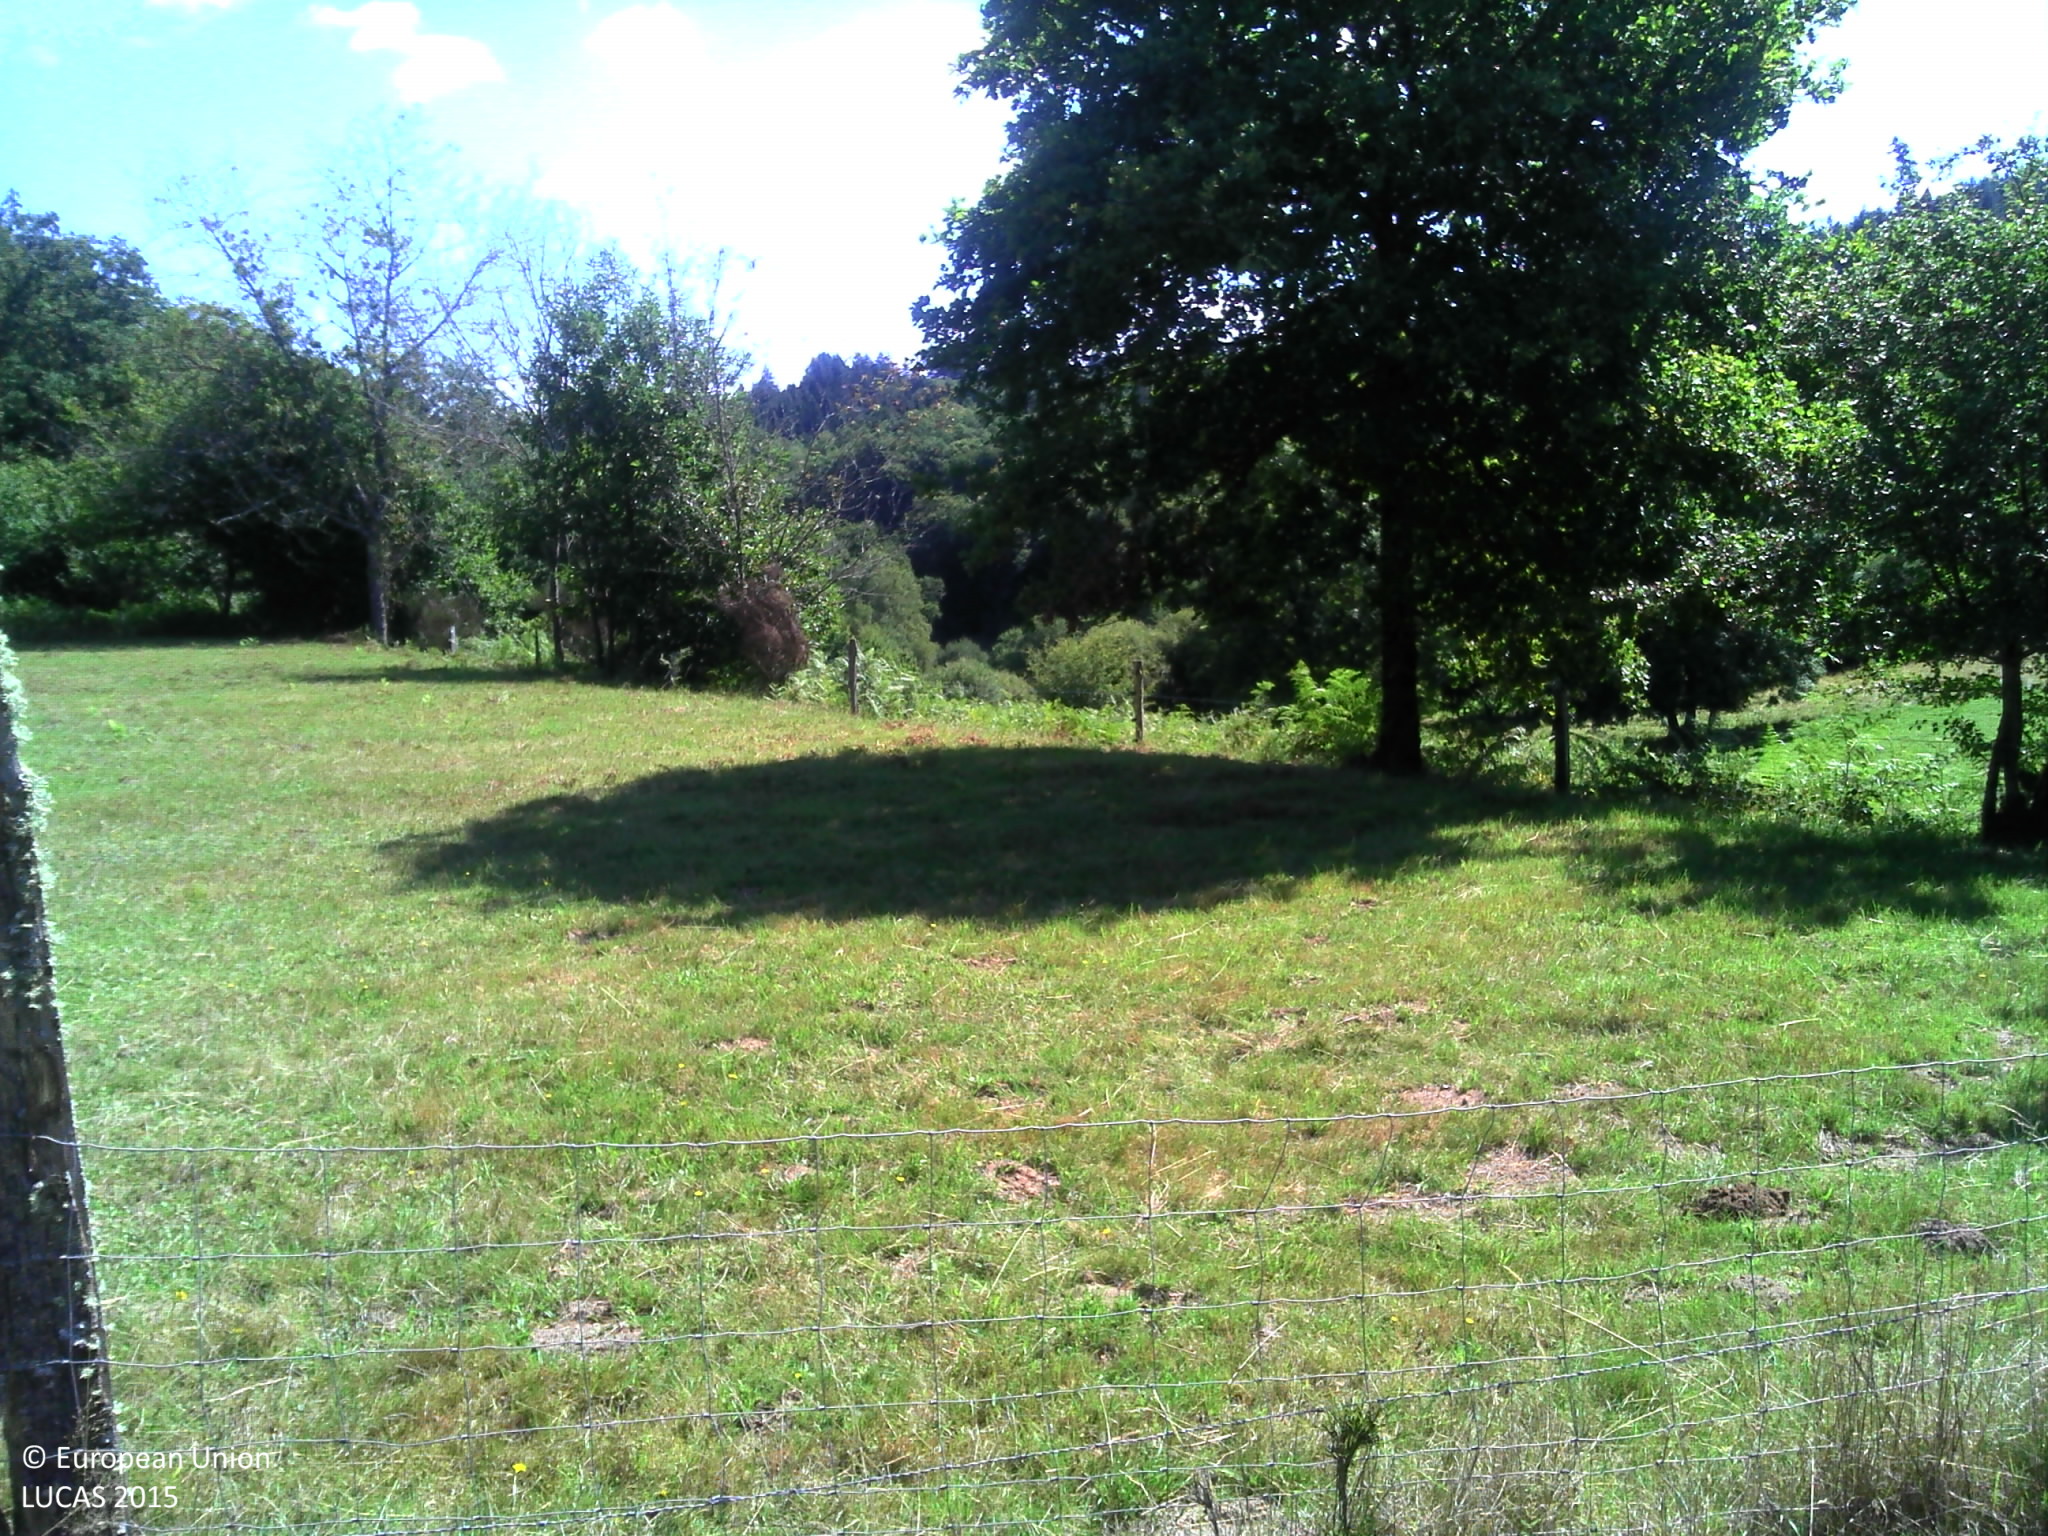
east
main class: Grassland
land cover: Grassland without tree/shrub cover
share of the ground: > 75 %
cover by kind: herbaceous plants 100 %
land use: Agriculture (excluding fallow land and kitchen gardens)
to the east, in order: Grassland without tree/shrub cover; Fences; Grassland without tree/shrub cover; Fences; Managed hedges; Dry stone walls; Grassland without tree/shrub cover; Spontaneously vegetated surfaces; Broadleaved woodland; Spontaneously vegetated surfaces; Fences; Broadleaved woodland; Rivers and streams; Ponds and wetlands; Grassland without tree/shrub cover; Single bushes/trees; Grassland without tree/shrub cover; Broadleaved woodland
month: August
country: FR
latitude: 45.8204
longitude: 1.8211
